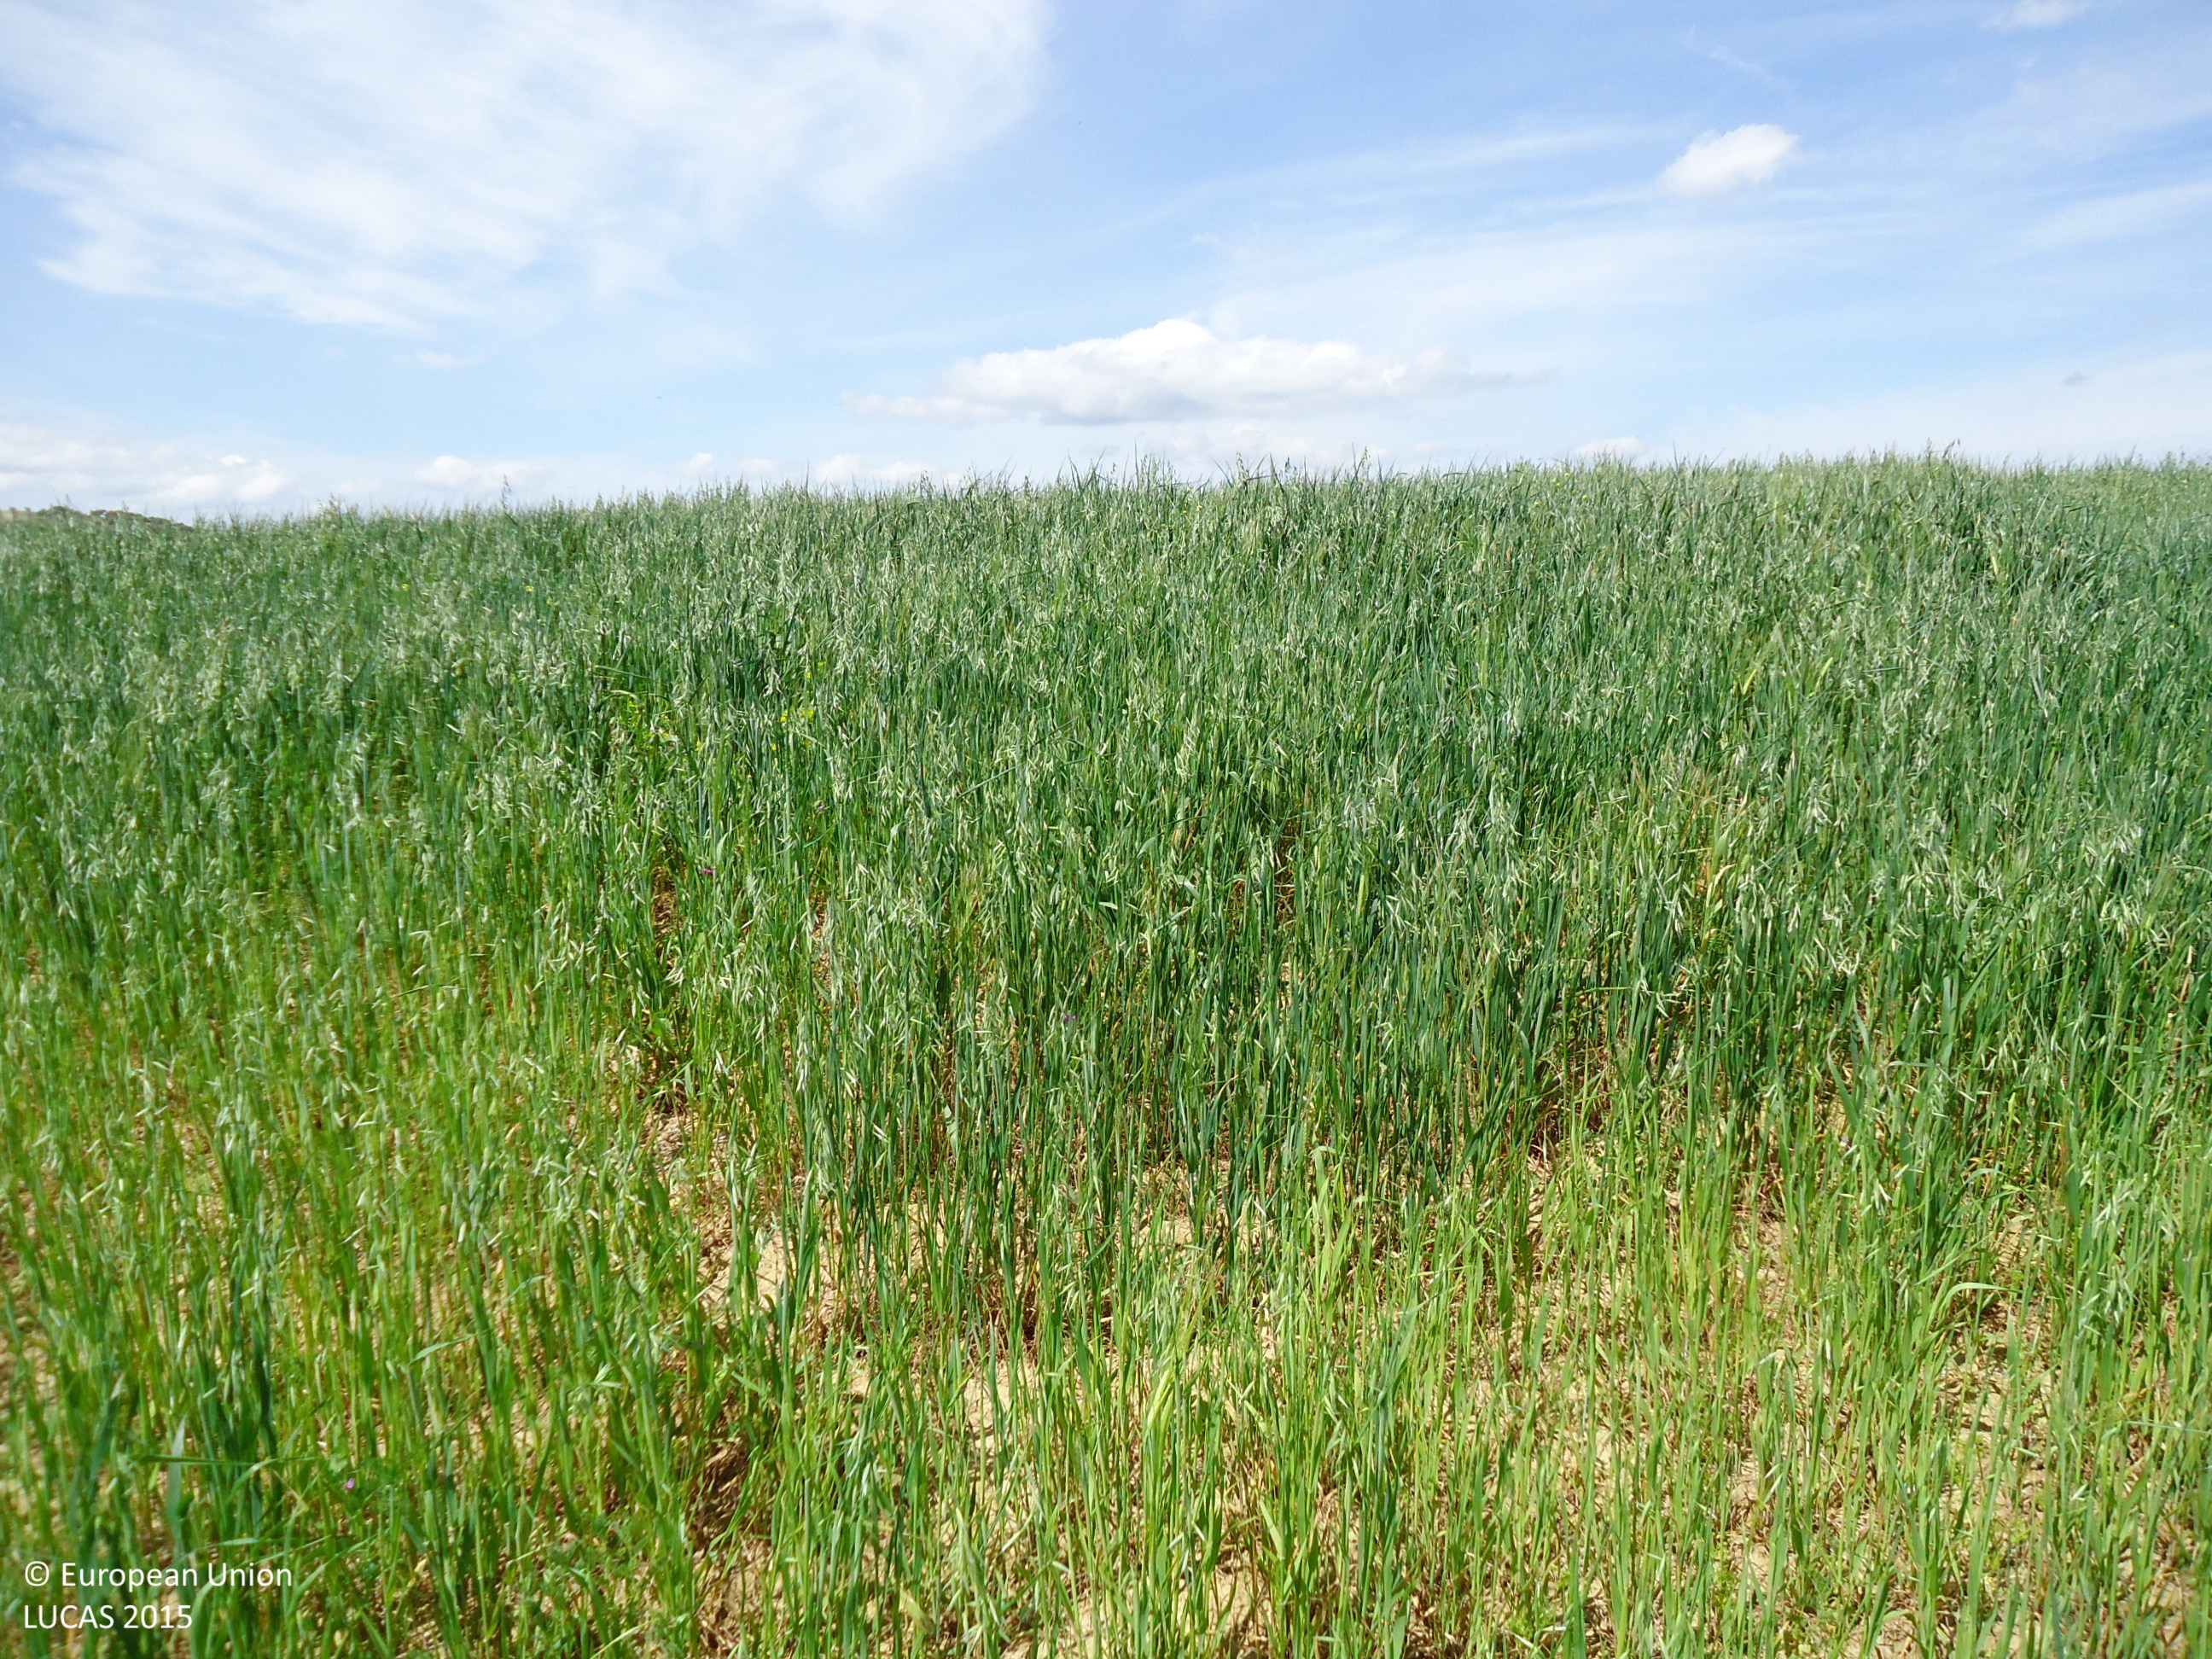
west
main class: Cropland
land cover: Oats
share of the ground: > 75 %
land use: Agriculture (excluding fallow land and kitchen gardens)
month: April
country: ES
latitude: 36.8923
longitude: -5.2756
